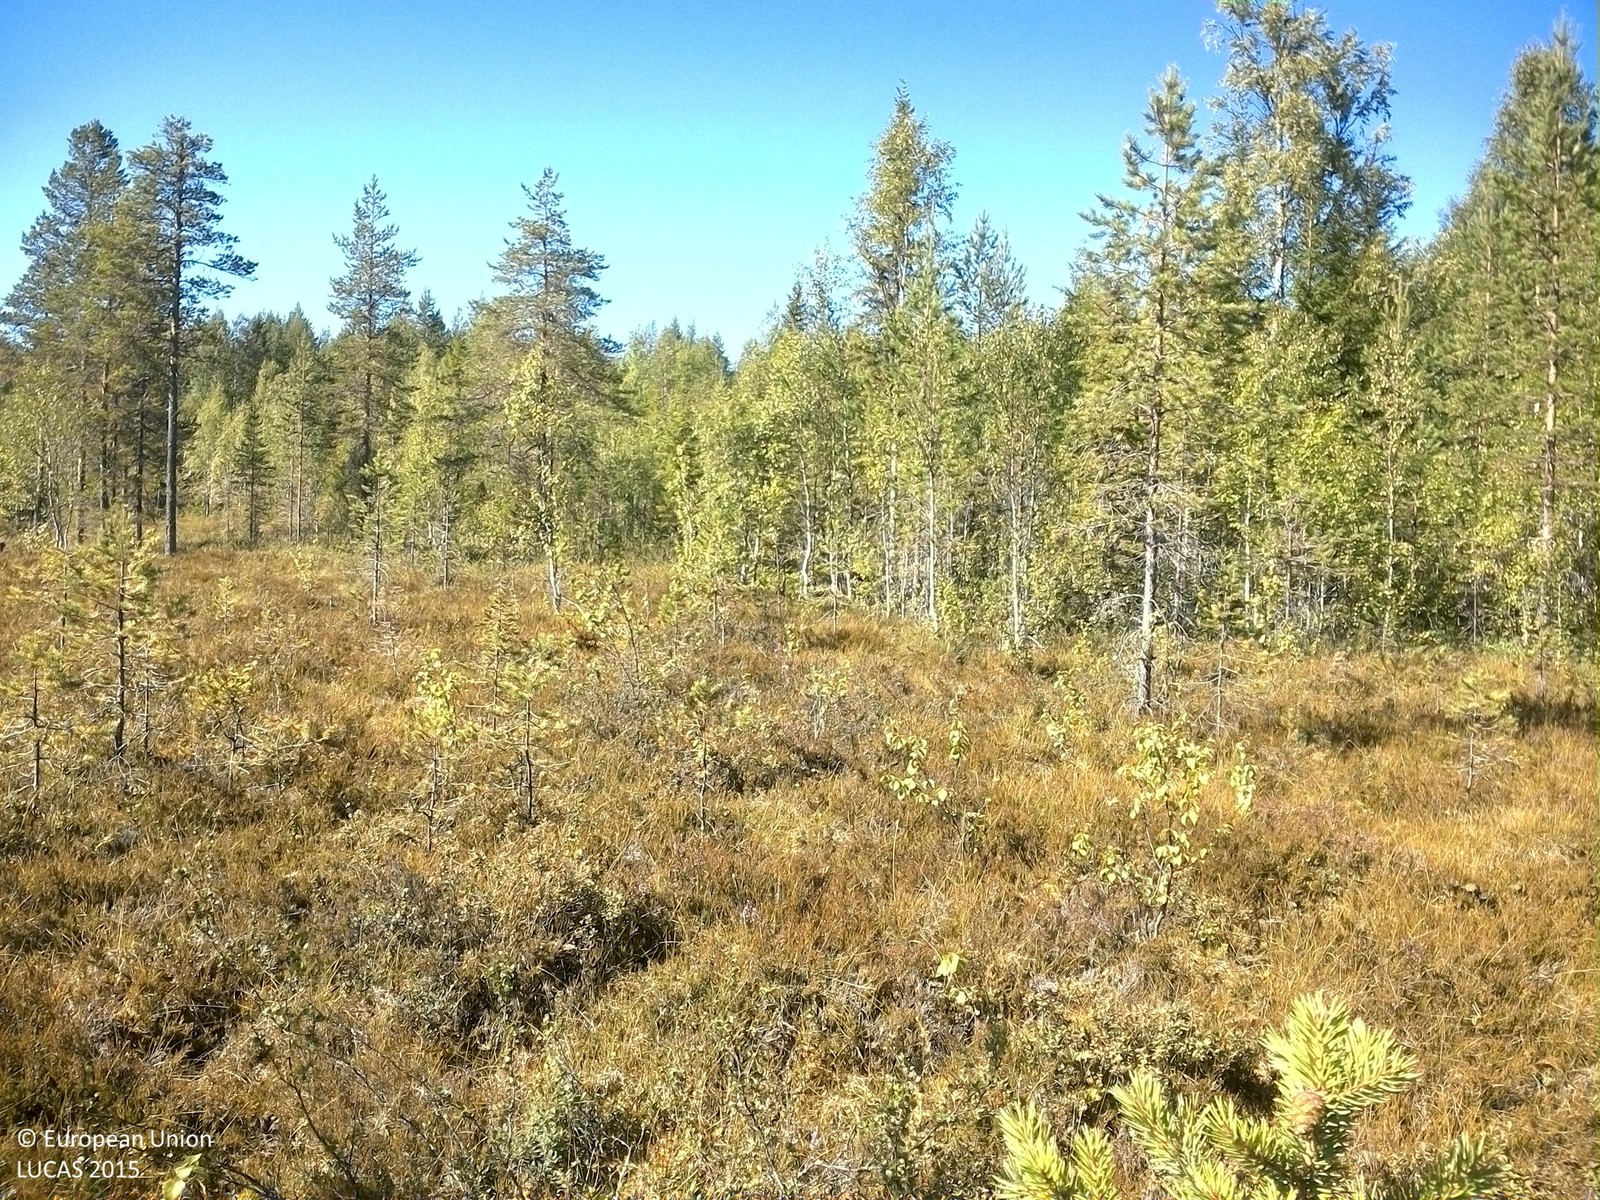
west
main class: Woodland
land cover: Pine dominated coniferous woodland
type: boreal forest
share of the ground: 10 - 25 %
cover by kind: shrubs 50 %, coniferous forest trees 20 %, lichens and mosses 15 %, herbaceous plants 10 %, broadleaved forest trees 5 %
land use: Semi-natural and natural areas not in use
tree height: < 5 m
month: August
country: SE
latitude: 63.7317
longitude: 17.8509
